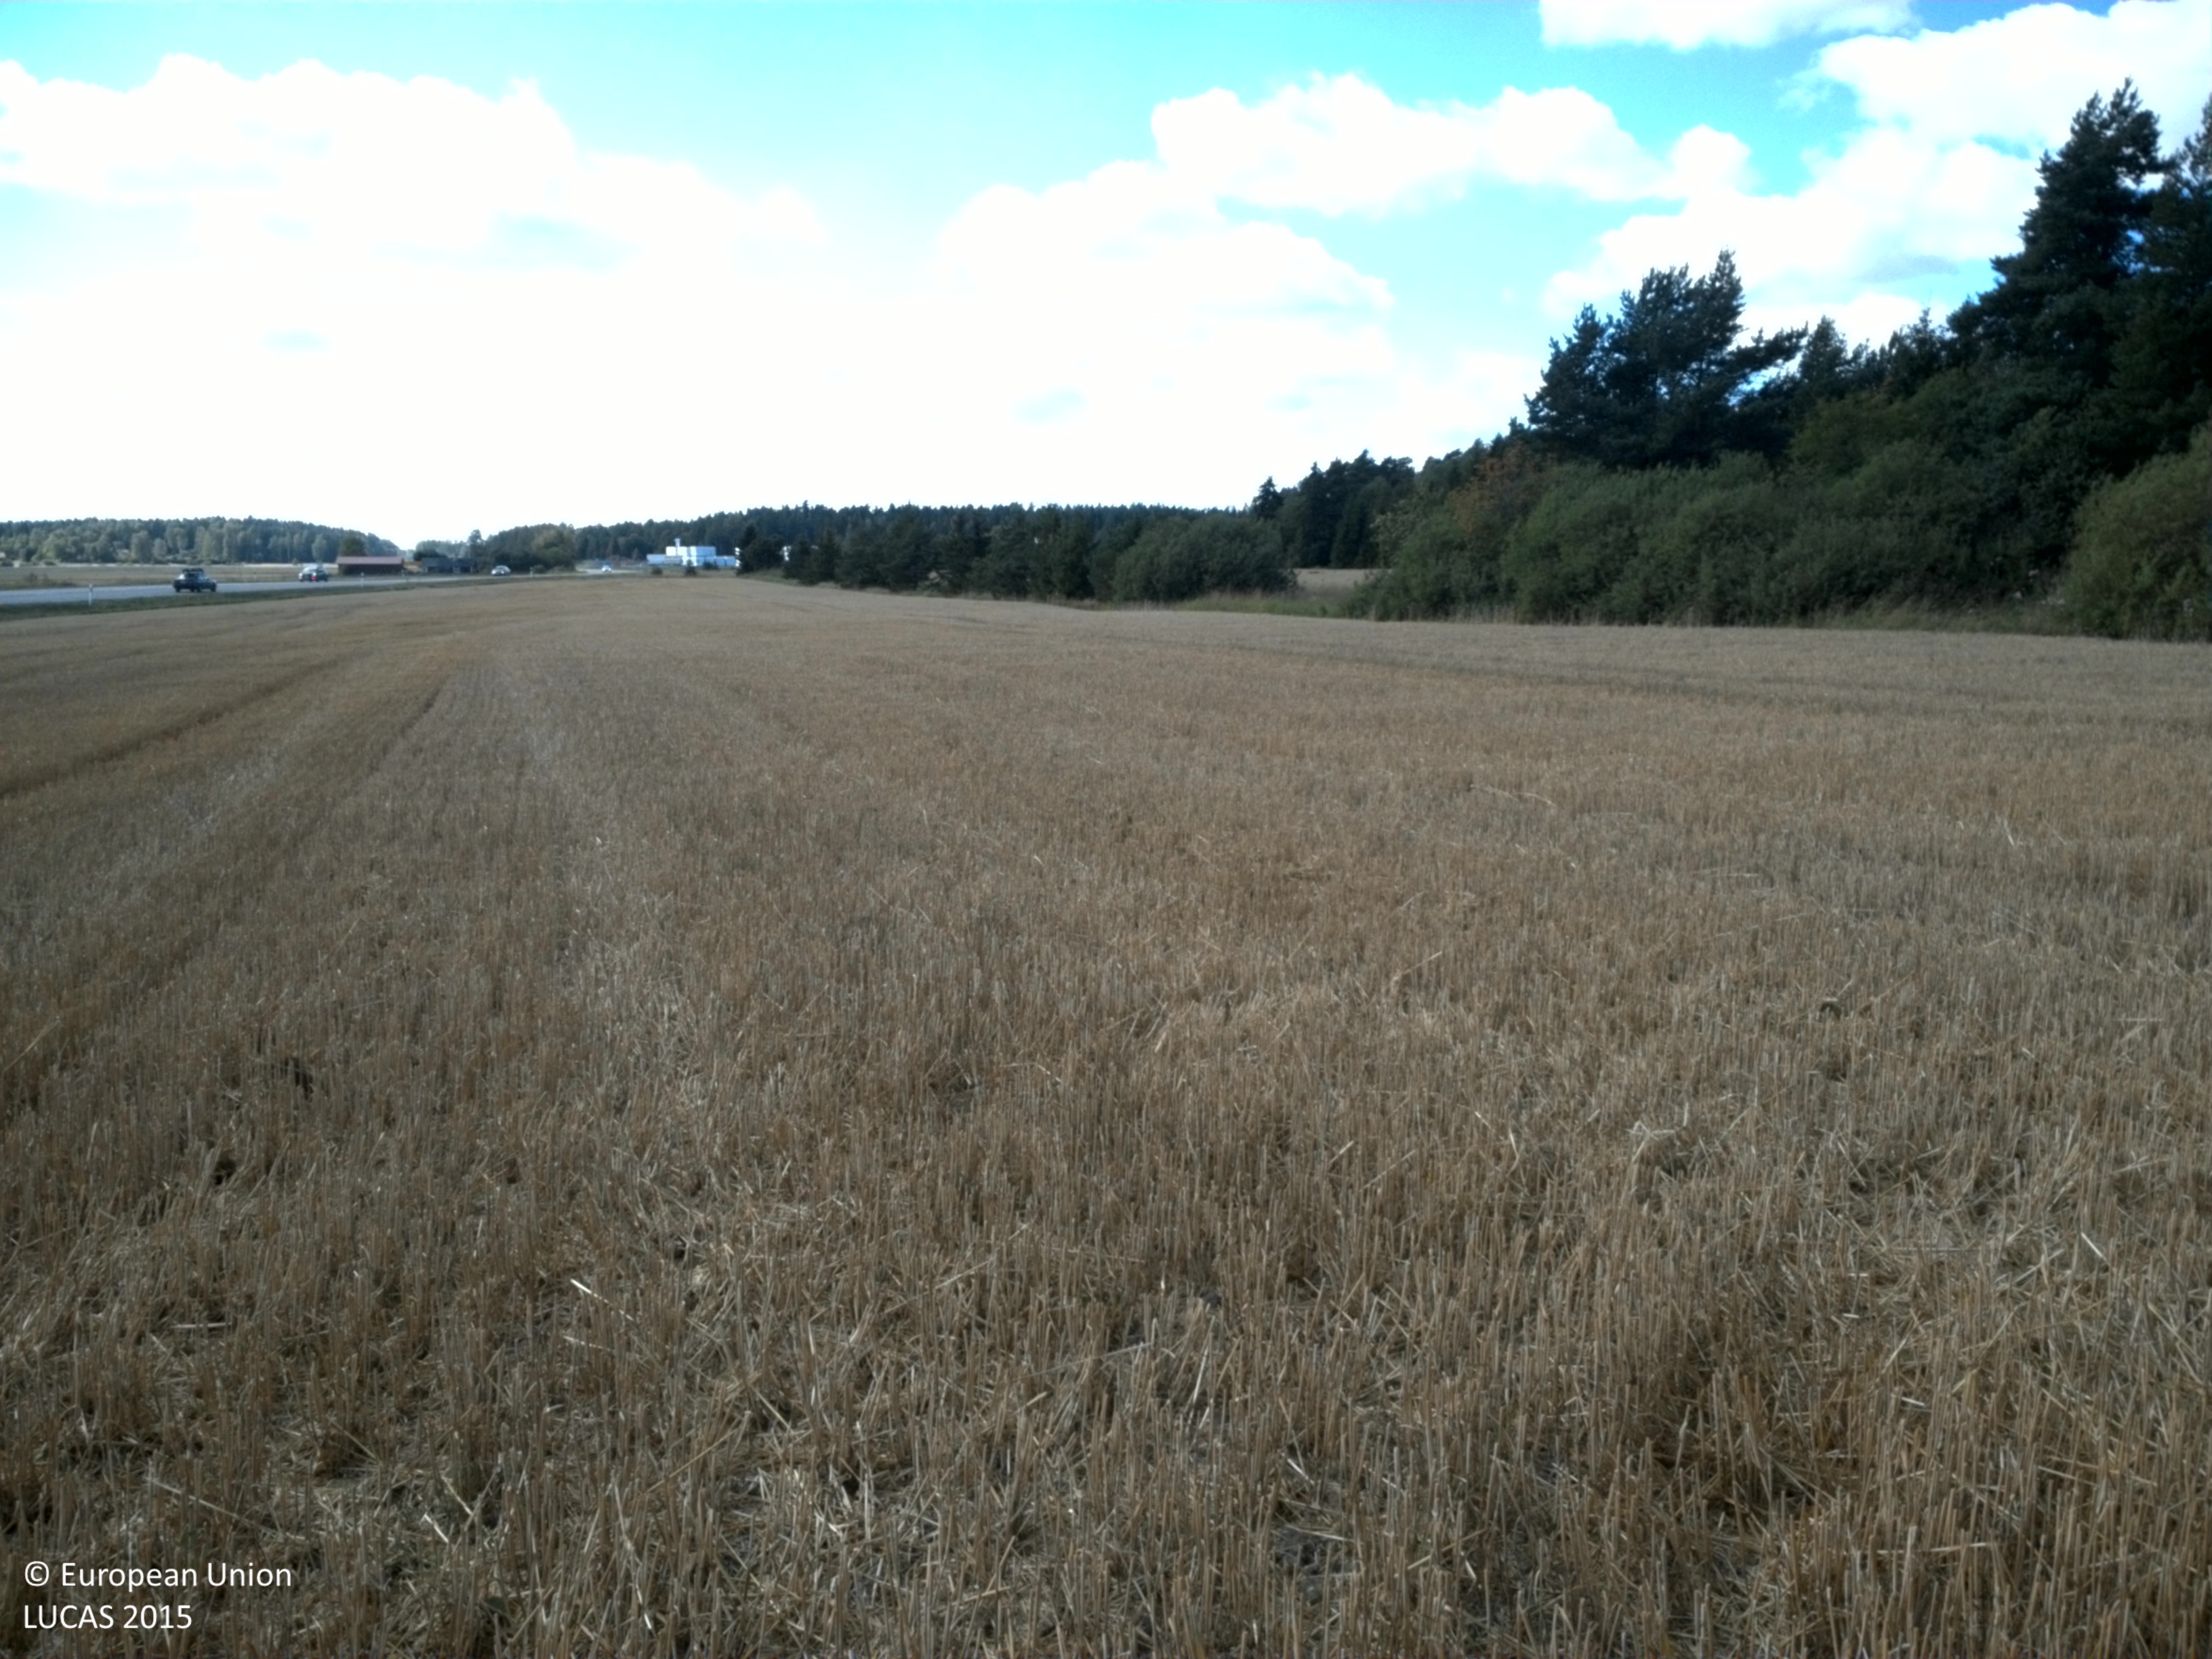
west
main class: Cropland
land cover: Common wheat
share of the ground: > 75 %
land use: Agriculture (excluding fallow land and kitchen gardens)
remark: Harvested field
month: August
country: SE
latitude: 59.6541
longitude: 17.1805
